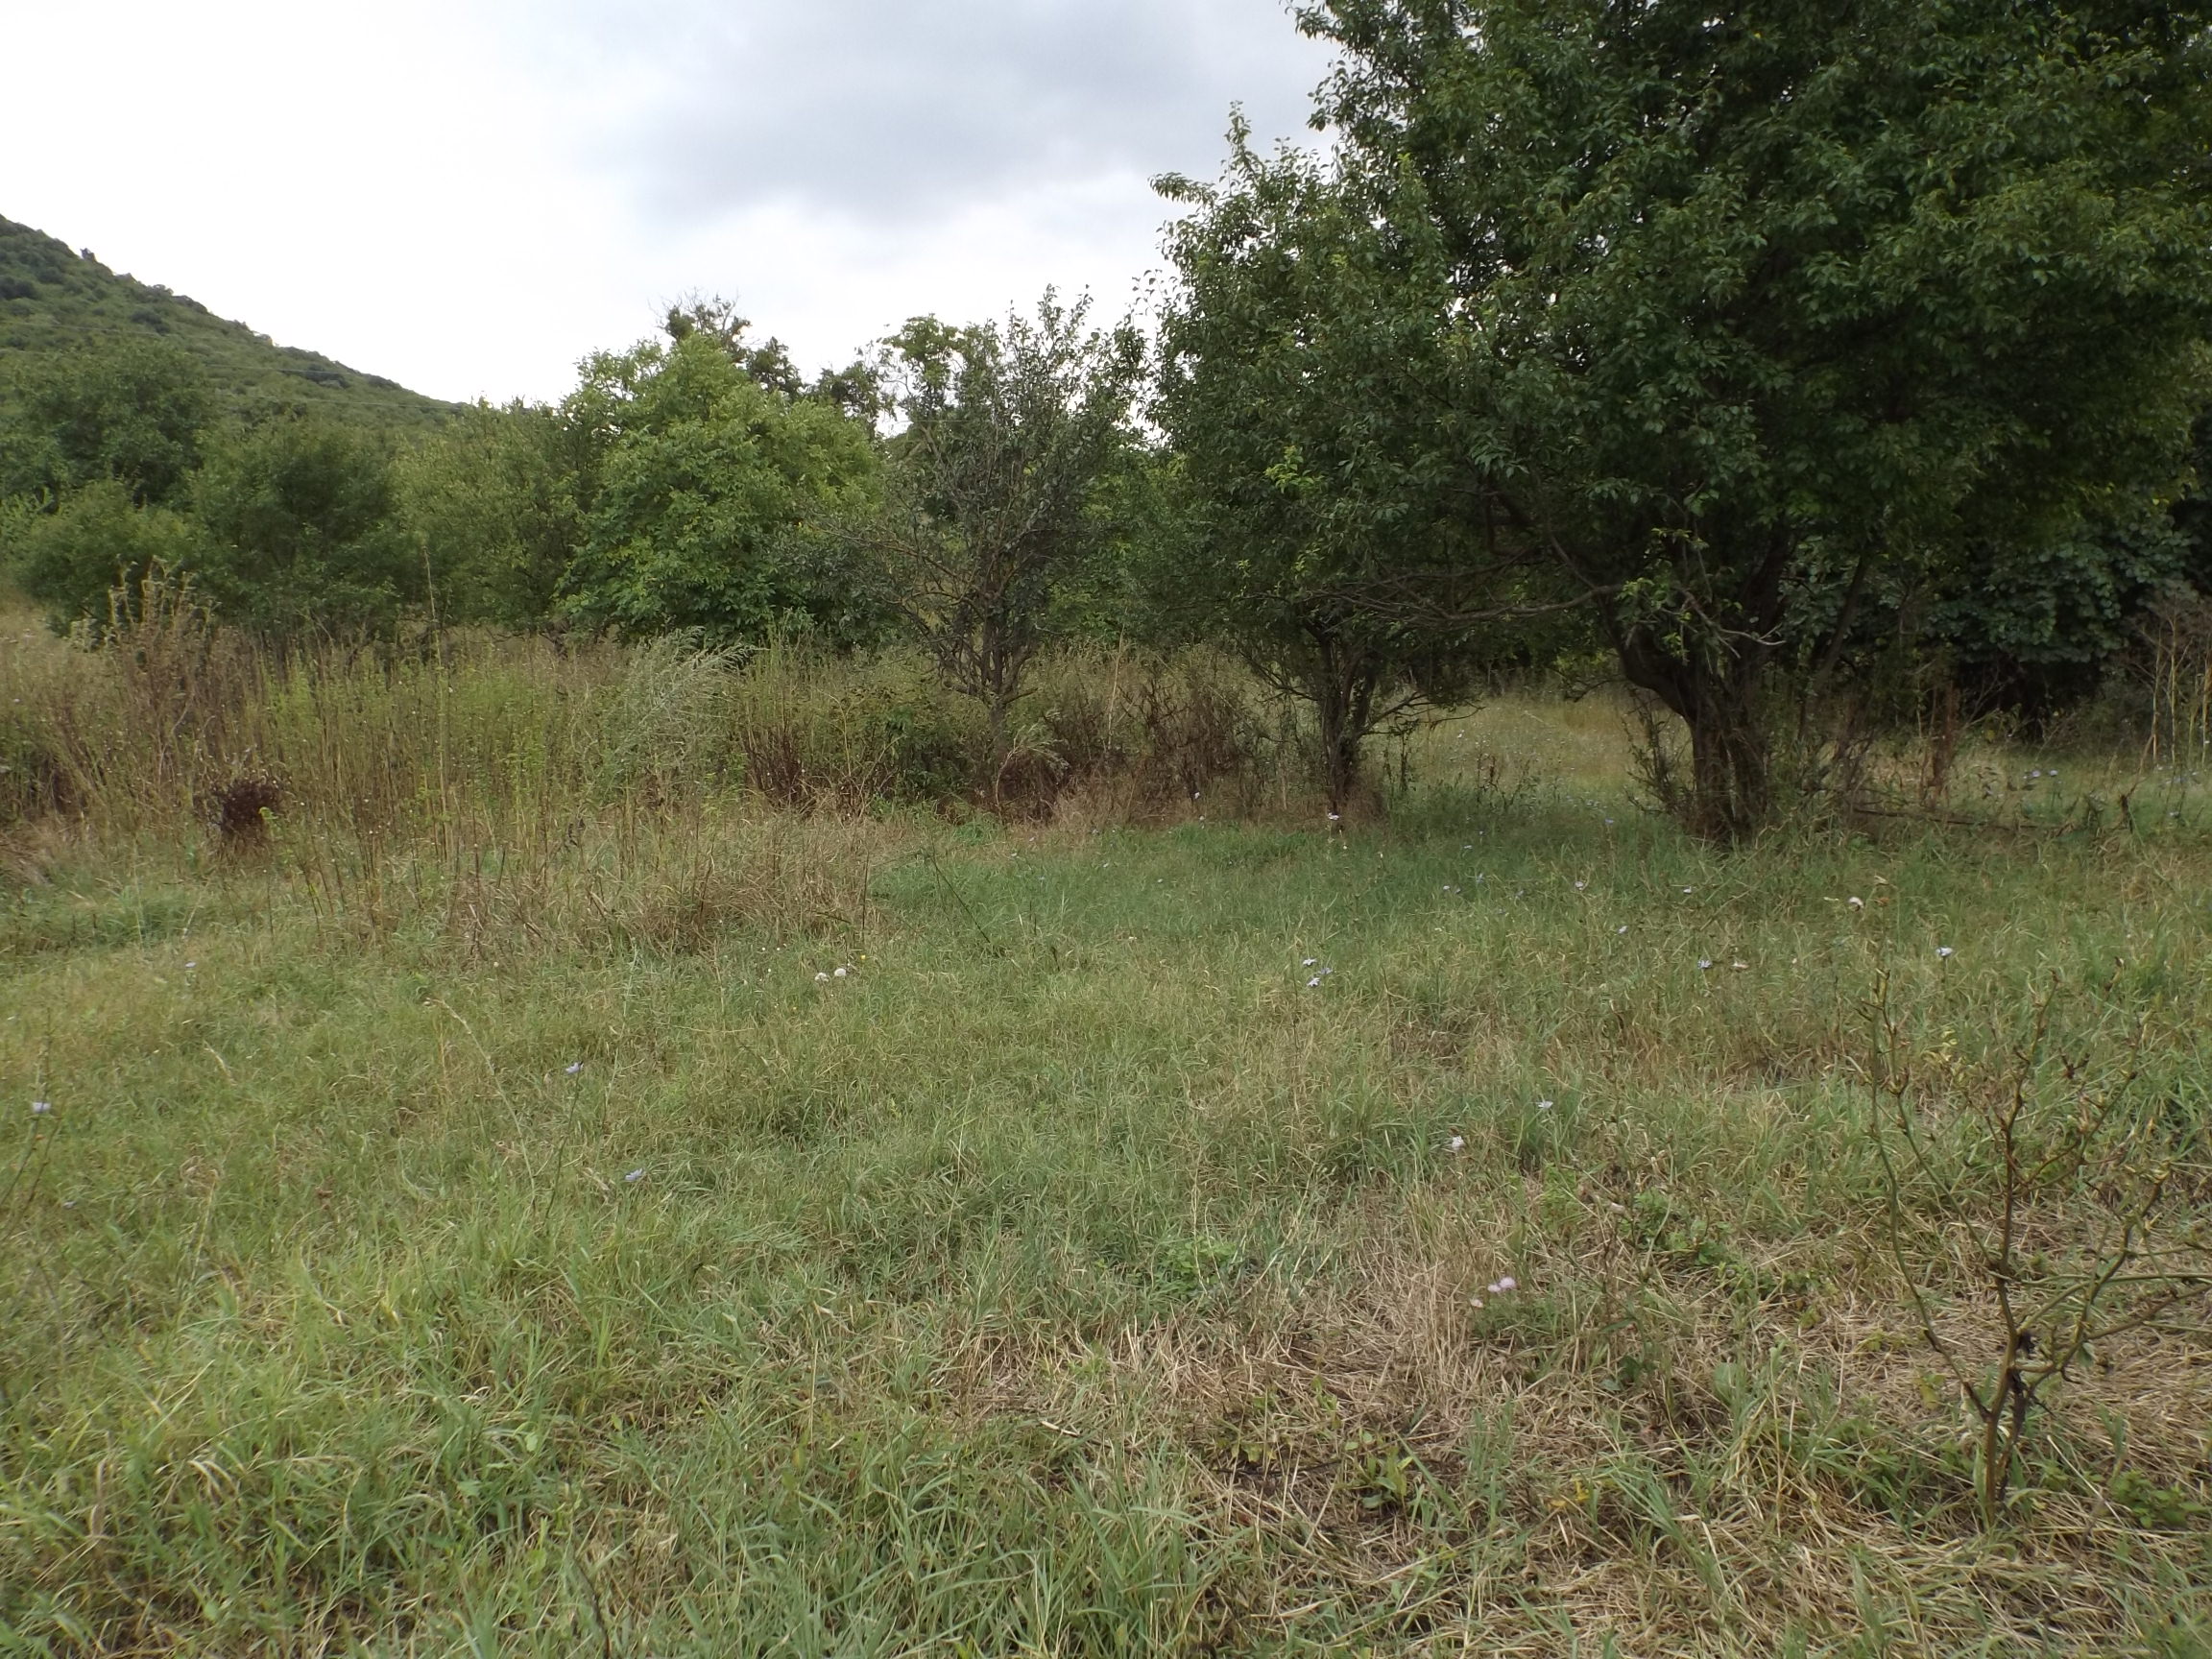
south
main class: Cropland
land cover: Cherry fruit
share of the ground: 10 - 25 %
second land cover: Grassland without tree/shrub cover
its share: > 75 %
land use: Abandoned areas
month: August
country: BG
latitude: 43.2090
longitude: 27.4439
